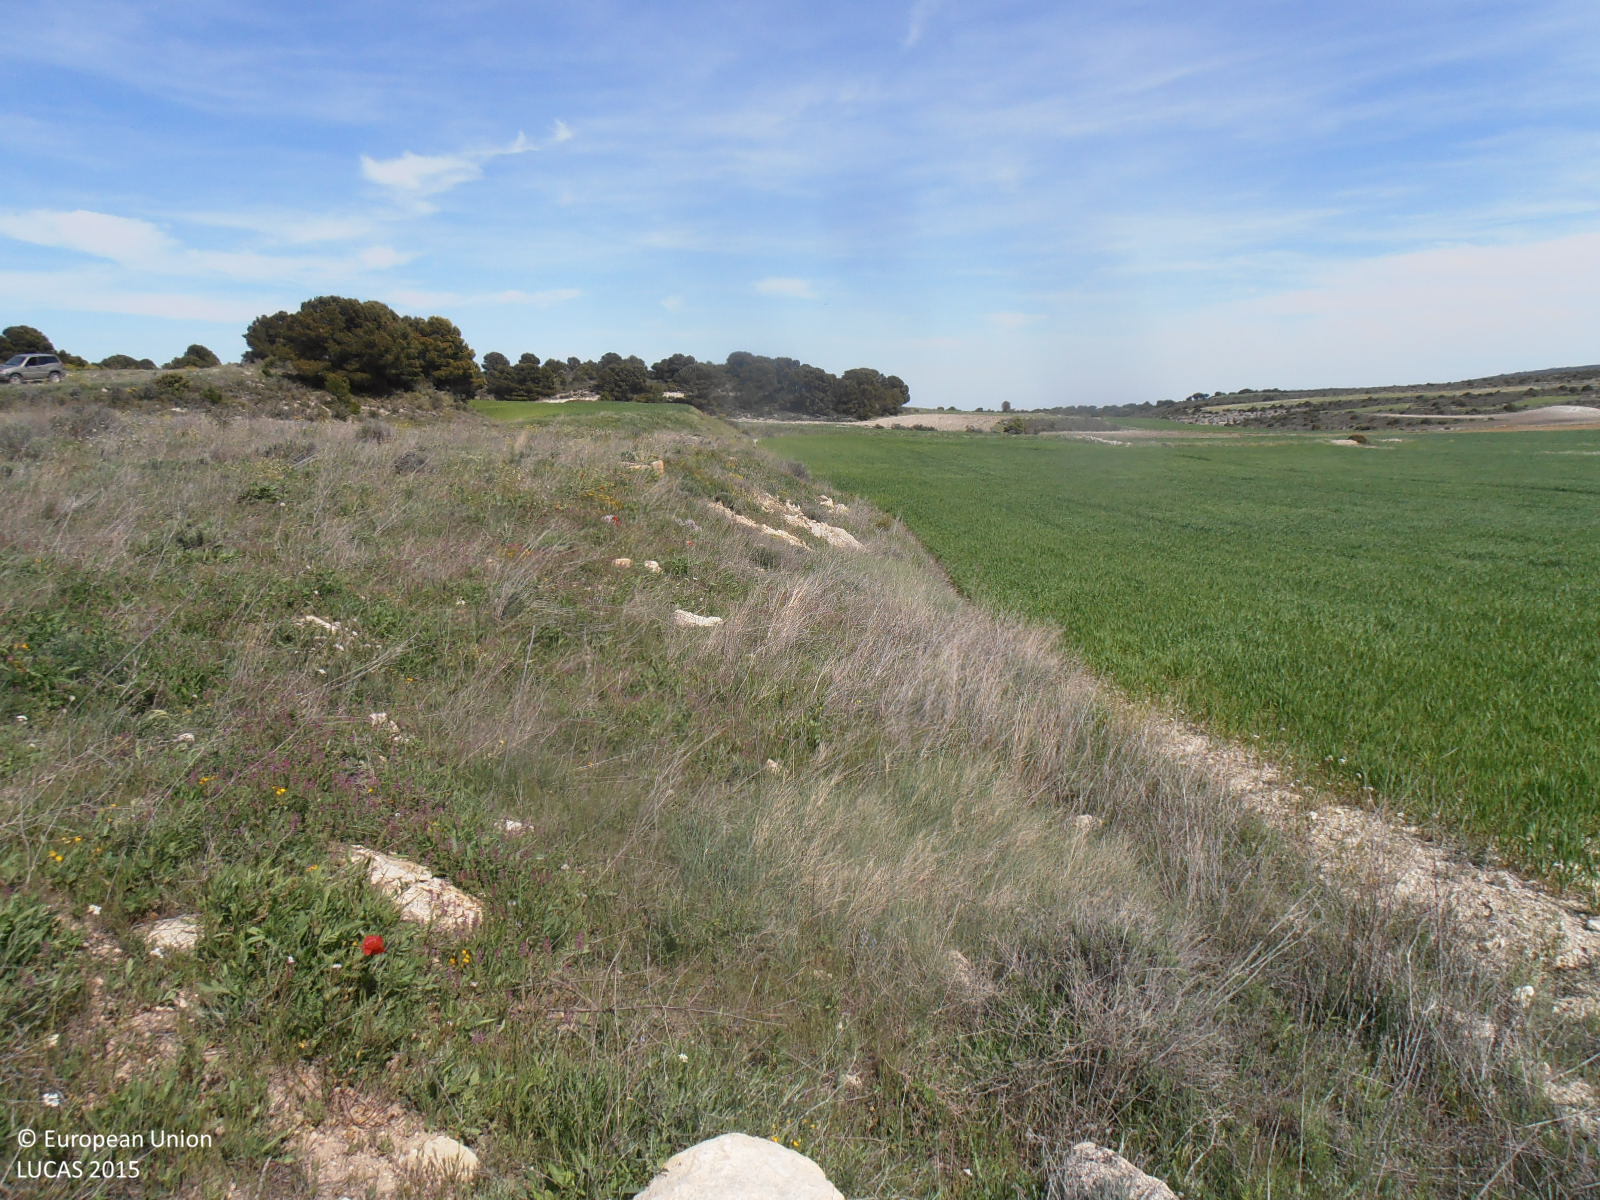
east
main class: Grassland
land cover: Grassland without tree/shrub cover
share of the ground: > 75 %
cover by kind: herbaceous plants 95 %, shrubs 5 %
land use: Abandoned areas
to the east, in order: Grassland without tree/shrub cover; Durum wheat; Grass margins; Durum wheat; Grass margins; Dry stone walls; Tracks; Shruby margins; Other bare soil
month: April
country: ES
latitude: 41.3655
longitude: -0.9583
